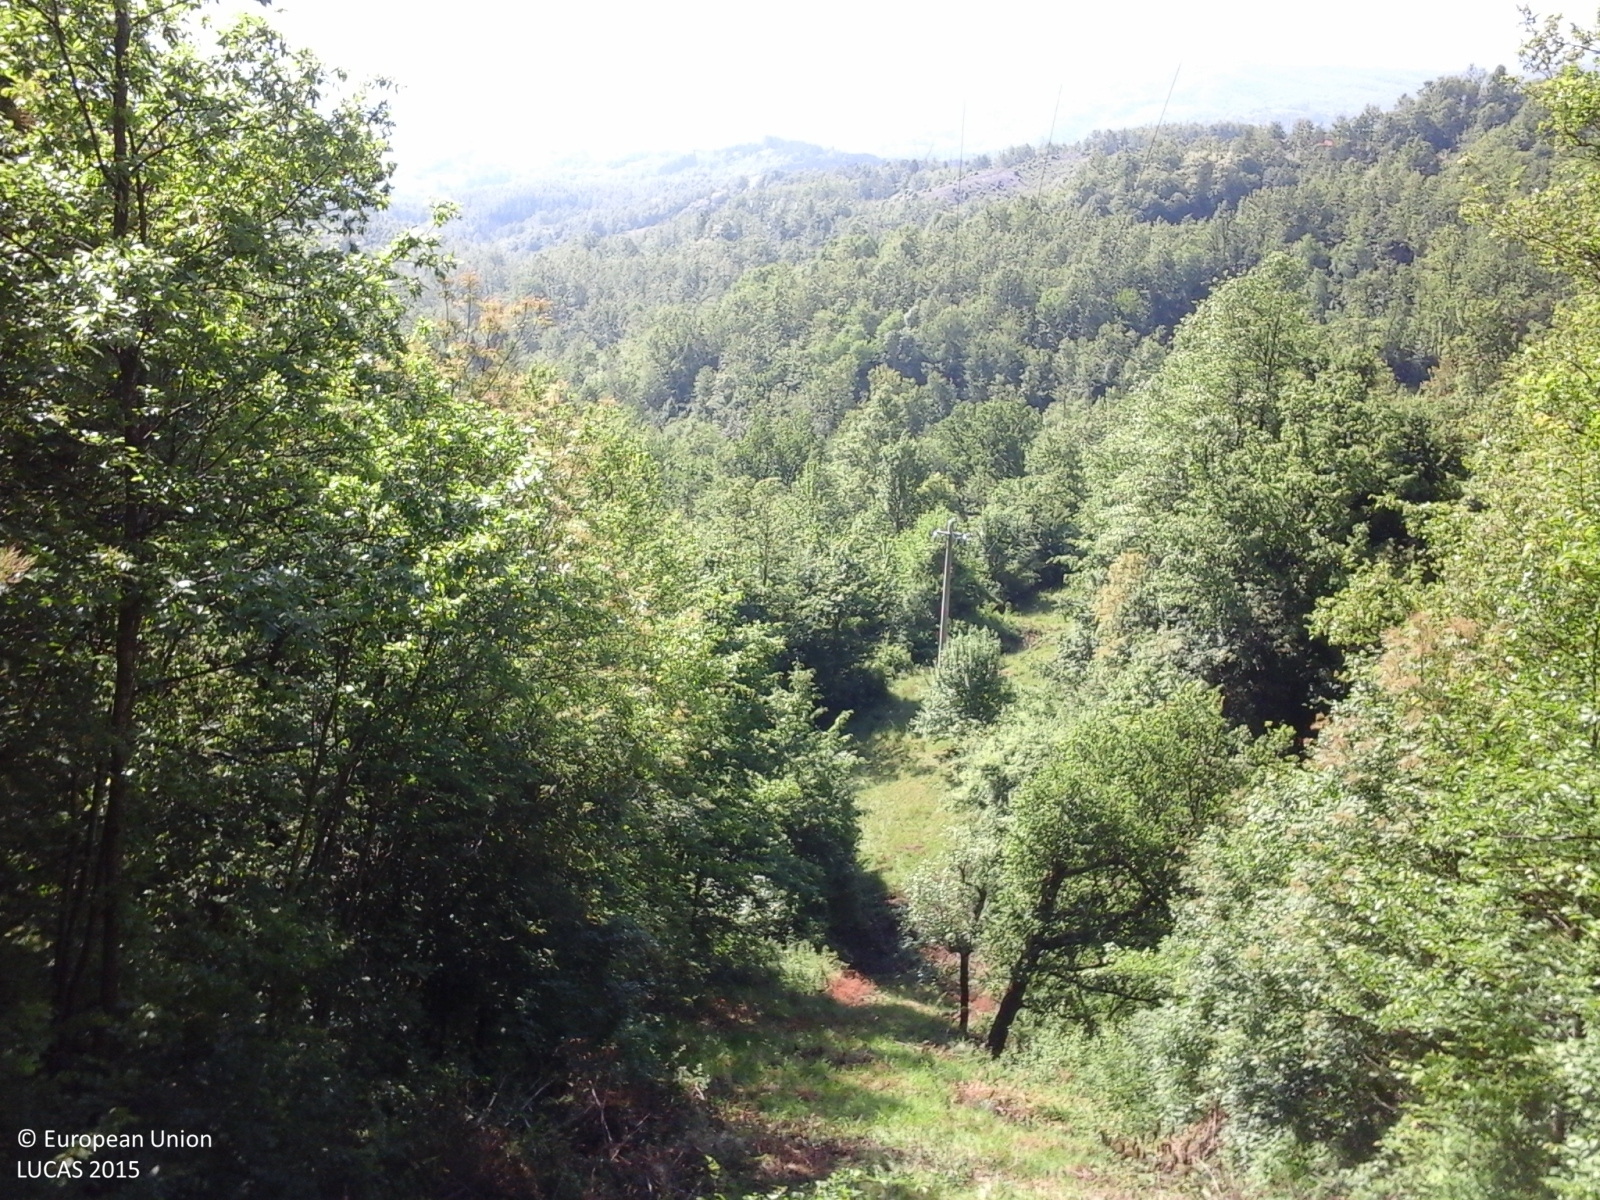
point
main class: Woodland
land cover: Broadleaved woodland
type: thermophilous deciduous forest
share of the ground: > 75 %
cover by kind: broadleaved forest trees 95 %, shrubs 5 %
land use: Forestry
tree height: > 5 m
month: May
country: IT
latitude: 44.5121
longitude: 9.6109
